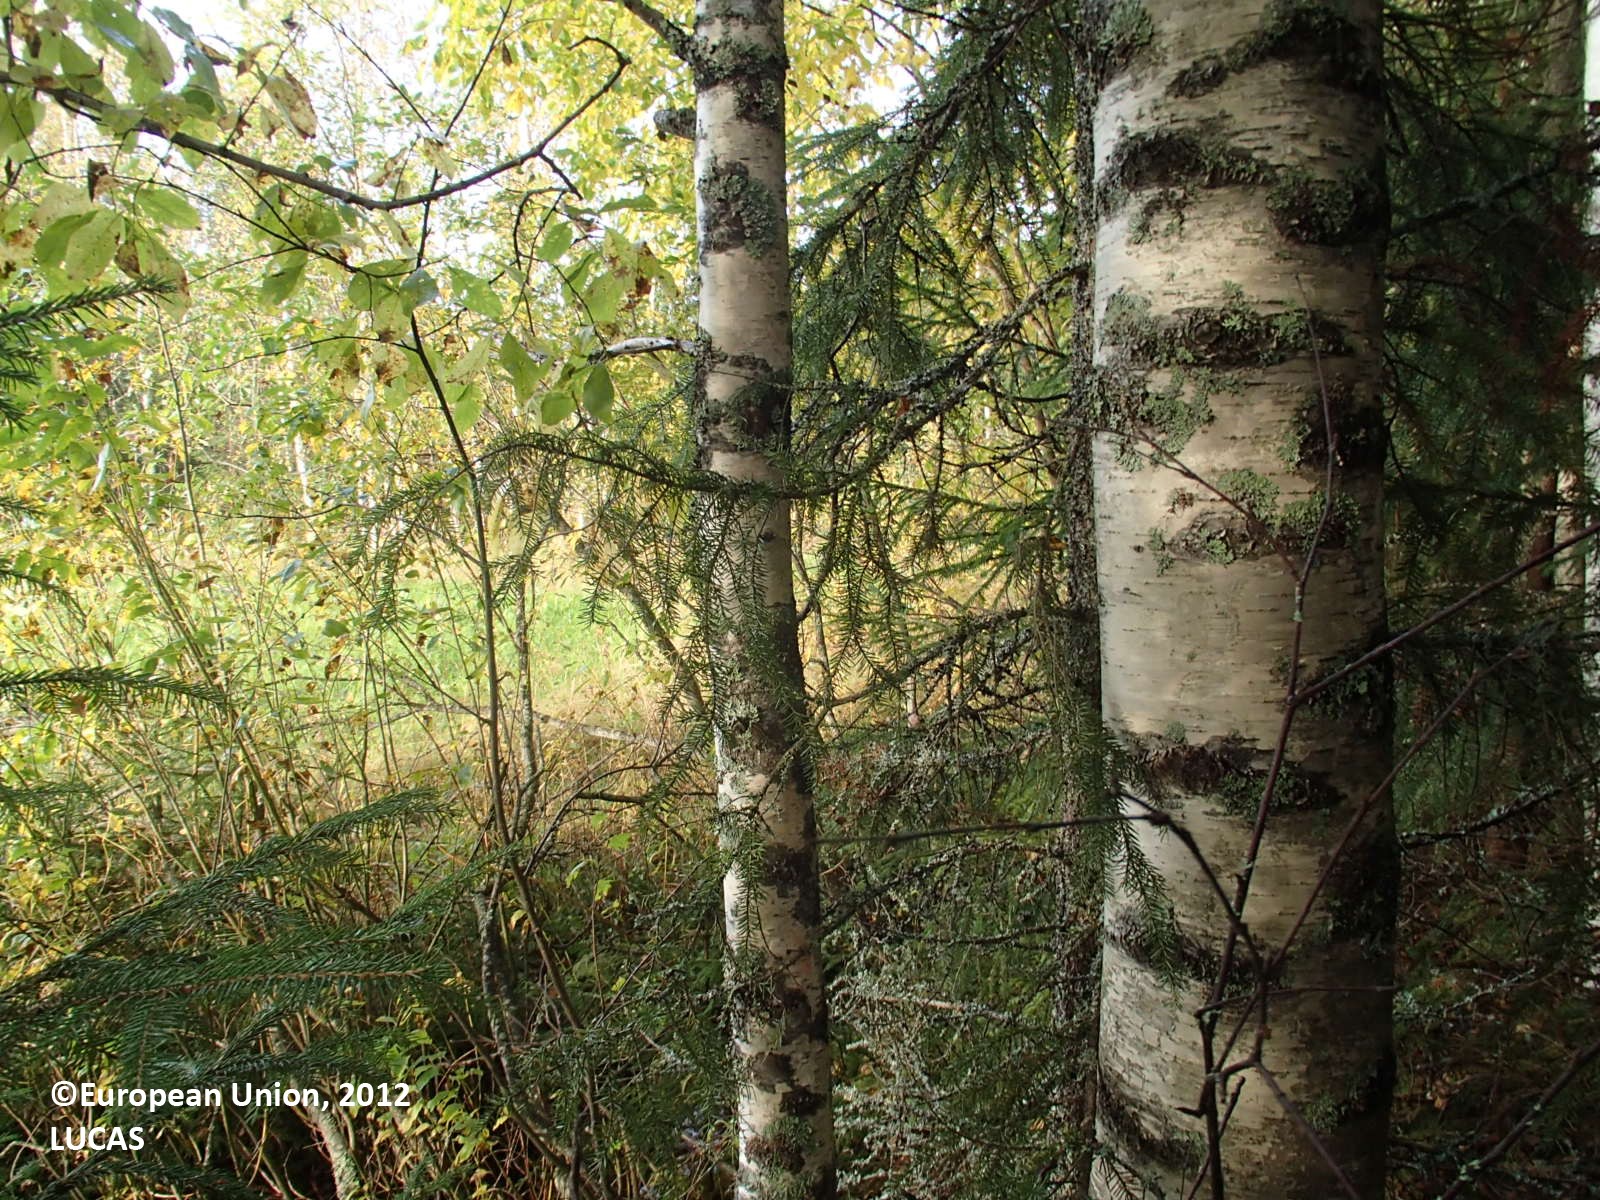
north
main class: Woodland
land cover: Spruce dominated mixed woodland
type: boreal forest
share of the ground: > 75 %
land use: Forestry
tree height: > 5 m
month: September
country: FI
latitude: 63.3448
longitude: 27.7682
